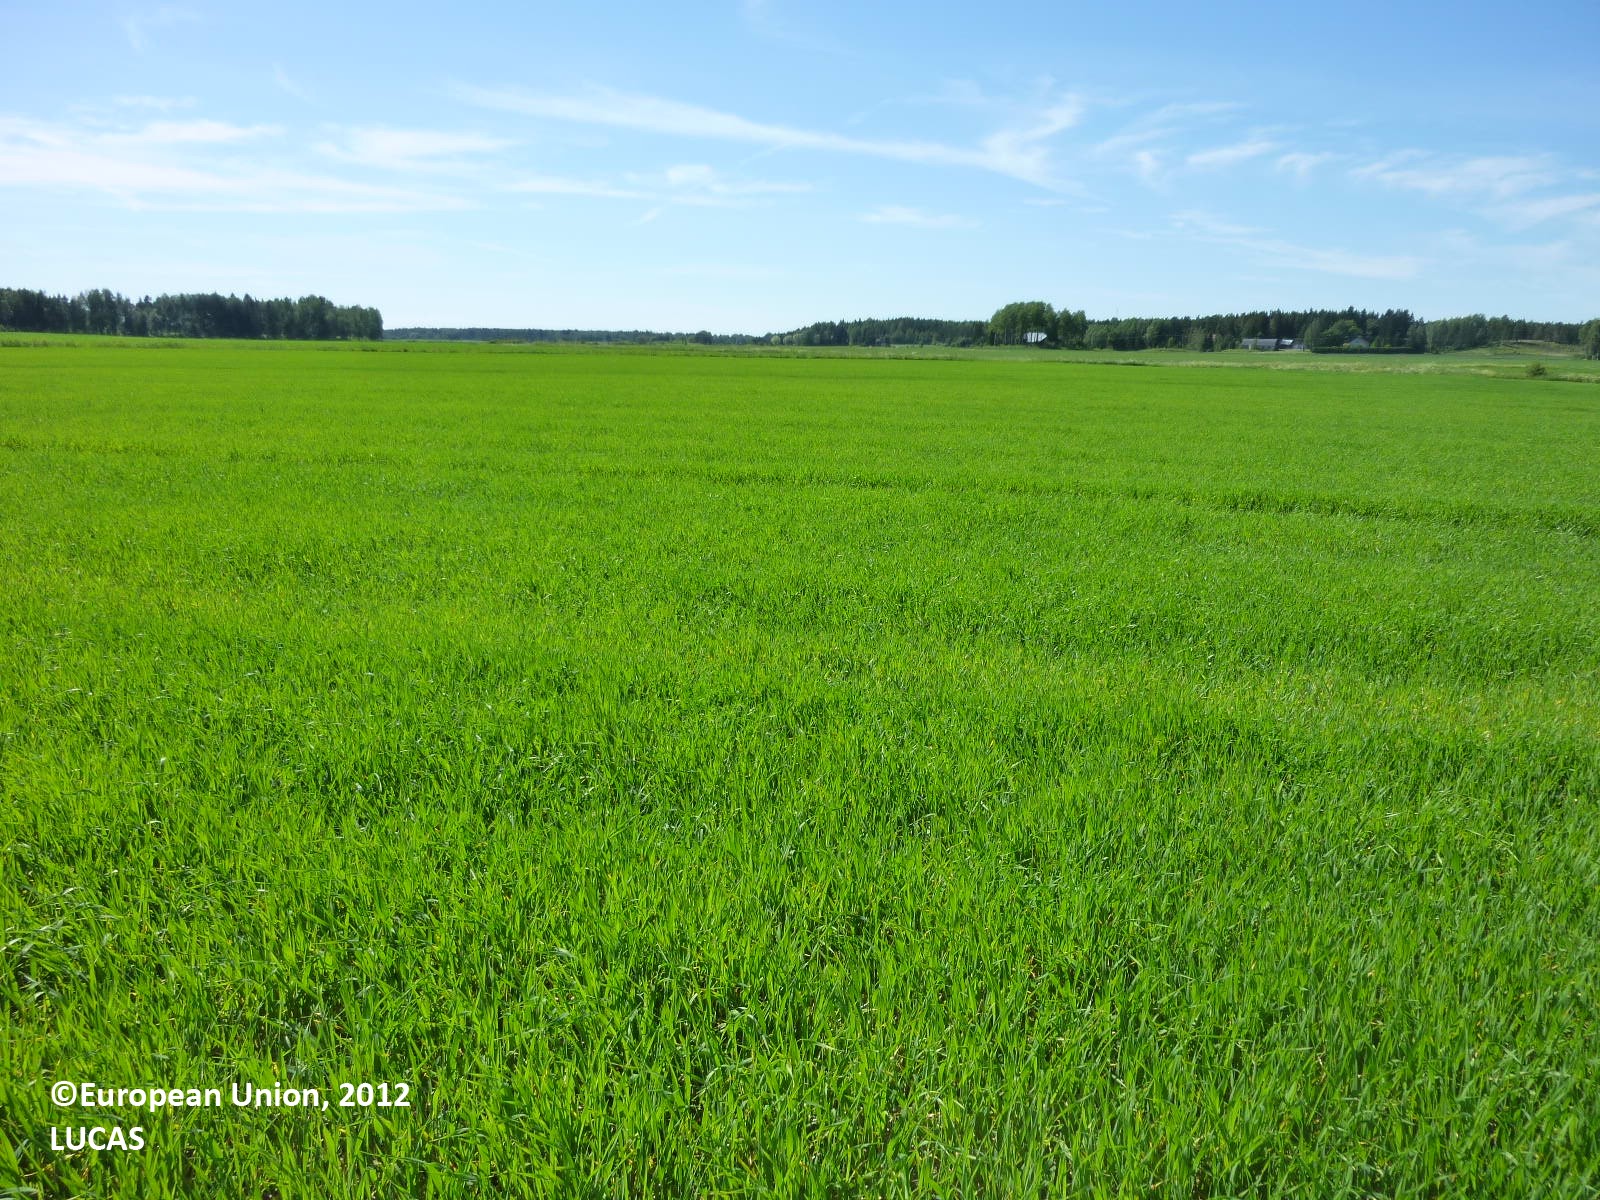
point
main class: Cropland
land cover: Barley
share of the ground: > 75 %
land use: Agriculture (excluding fallow land and kitchen gardens)
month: June
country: FI
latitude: 60.1081
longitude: 22.5761
